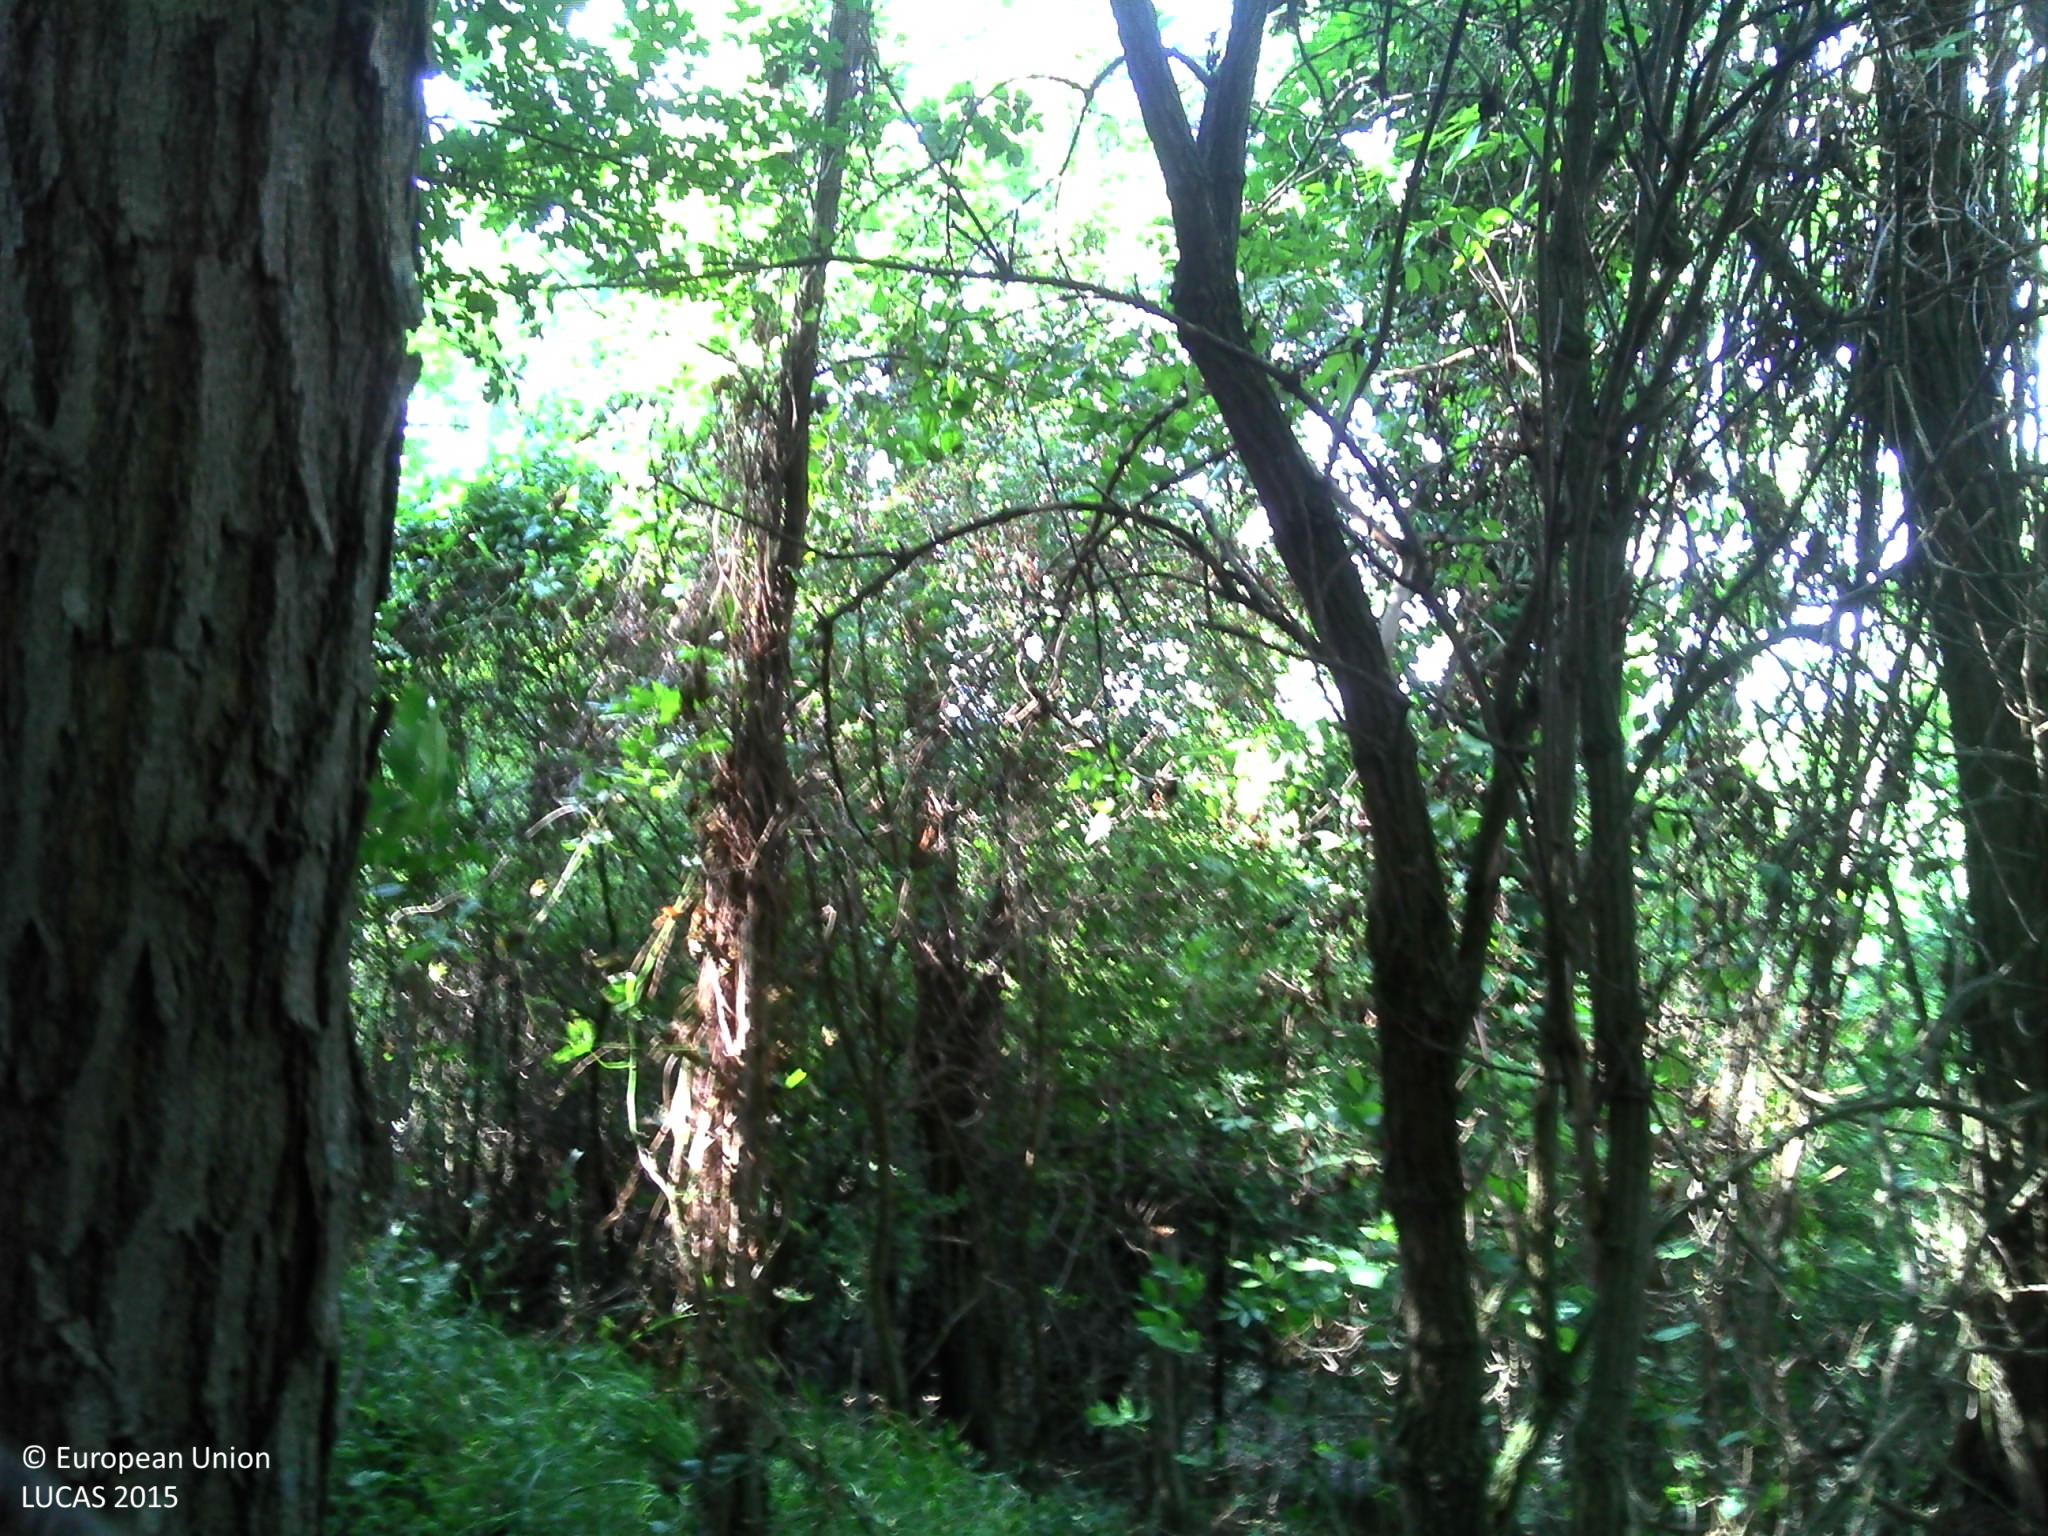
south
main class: Woodland
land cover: Broadleaved woodland
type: mesophytic deciduous forest
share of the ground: > 75 %
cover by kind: broadleaved forest trees 95 %, herbaceous plants 5 %
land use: Agriculture (excluding fallow land and kitchen gardens)
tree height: > 5 m
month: August
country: FR
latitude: 48.7918
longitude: 7.6186
